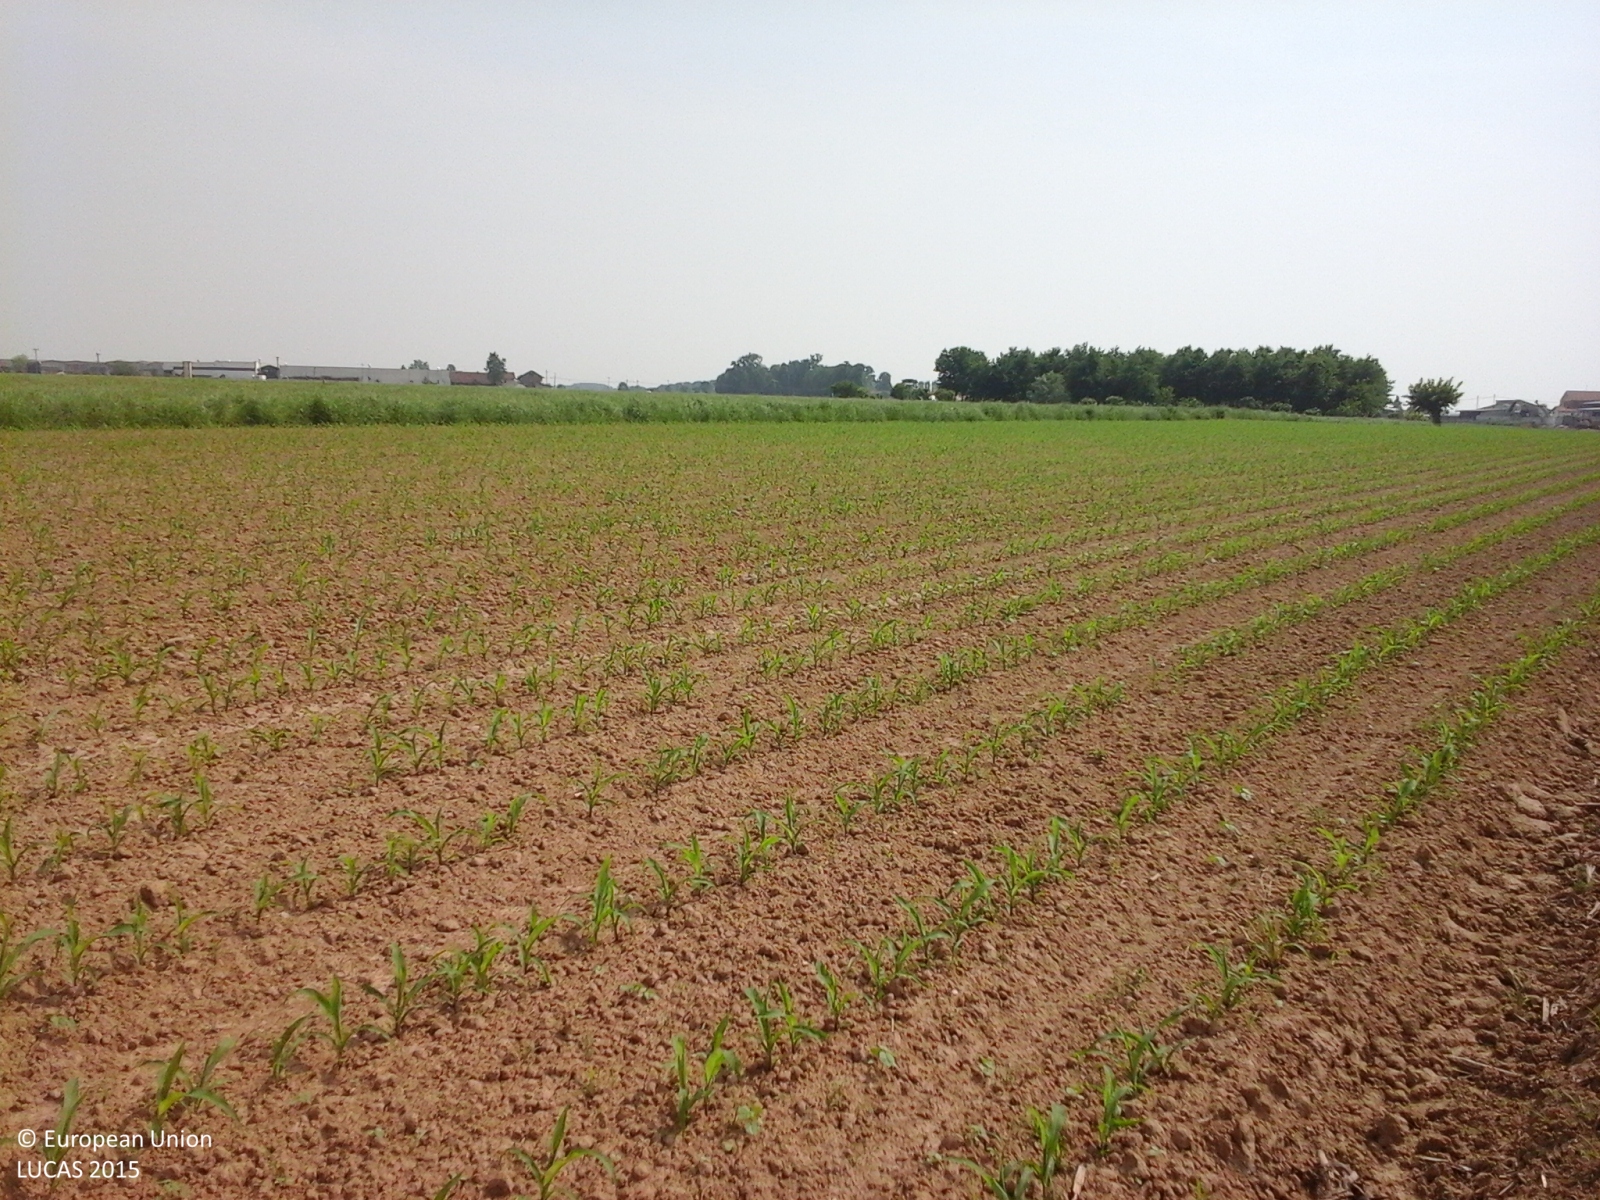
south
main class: Cropland
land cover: Maize
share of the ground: < 10 %
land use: Agriculture (excluding fallow land and kitchen gardens)
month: May
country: IT
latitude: 44.8141
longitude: 7.7913
